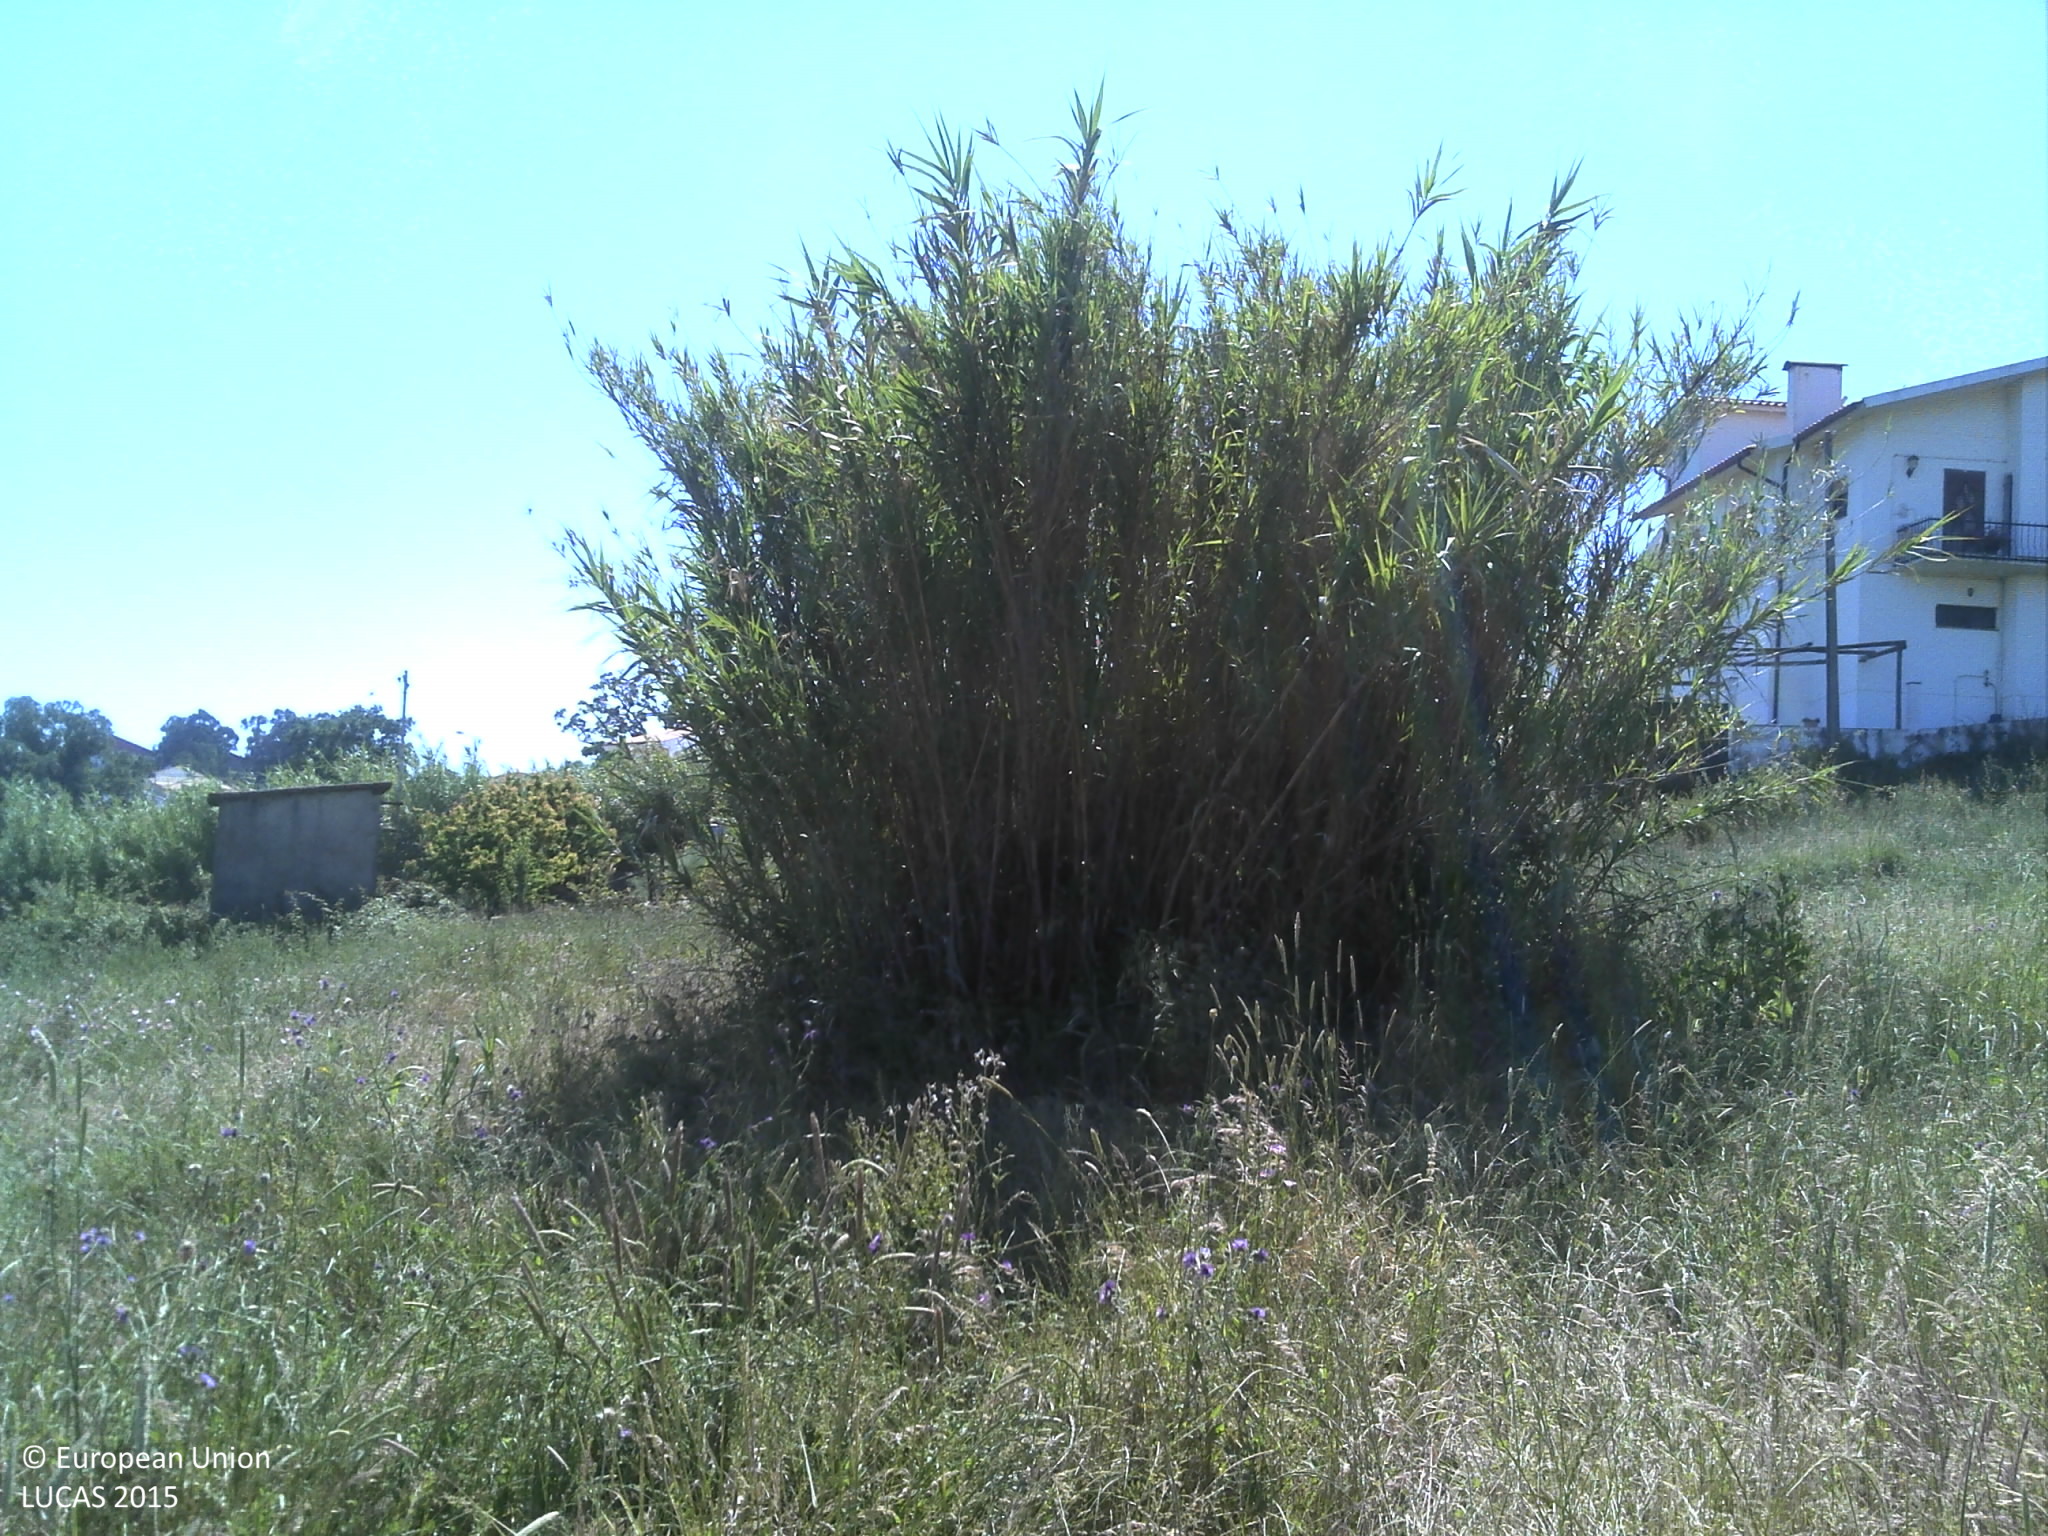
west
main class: Grassland
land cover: Grassland with sparse tree/shrub cover
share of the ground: > 75 %
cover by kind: herbaceous plants 75 %, unconsolidated bare surface 15 %, broadleaved forest trees 5 %
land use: Agriculture (excluding fallow land and kitchen gardens)
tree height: < 5 m
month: May
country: PT
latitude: 39.6025
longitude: -8.8701
